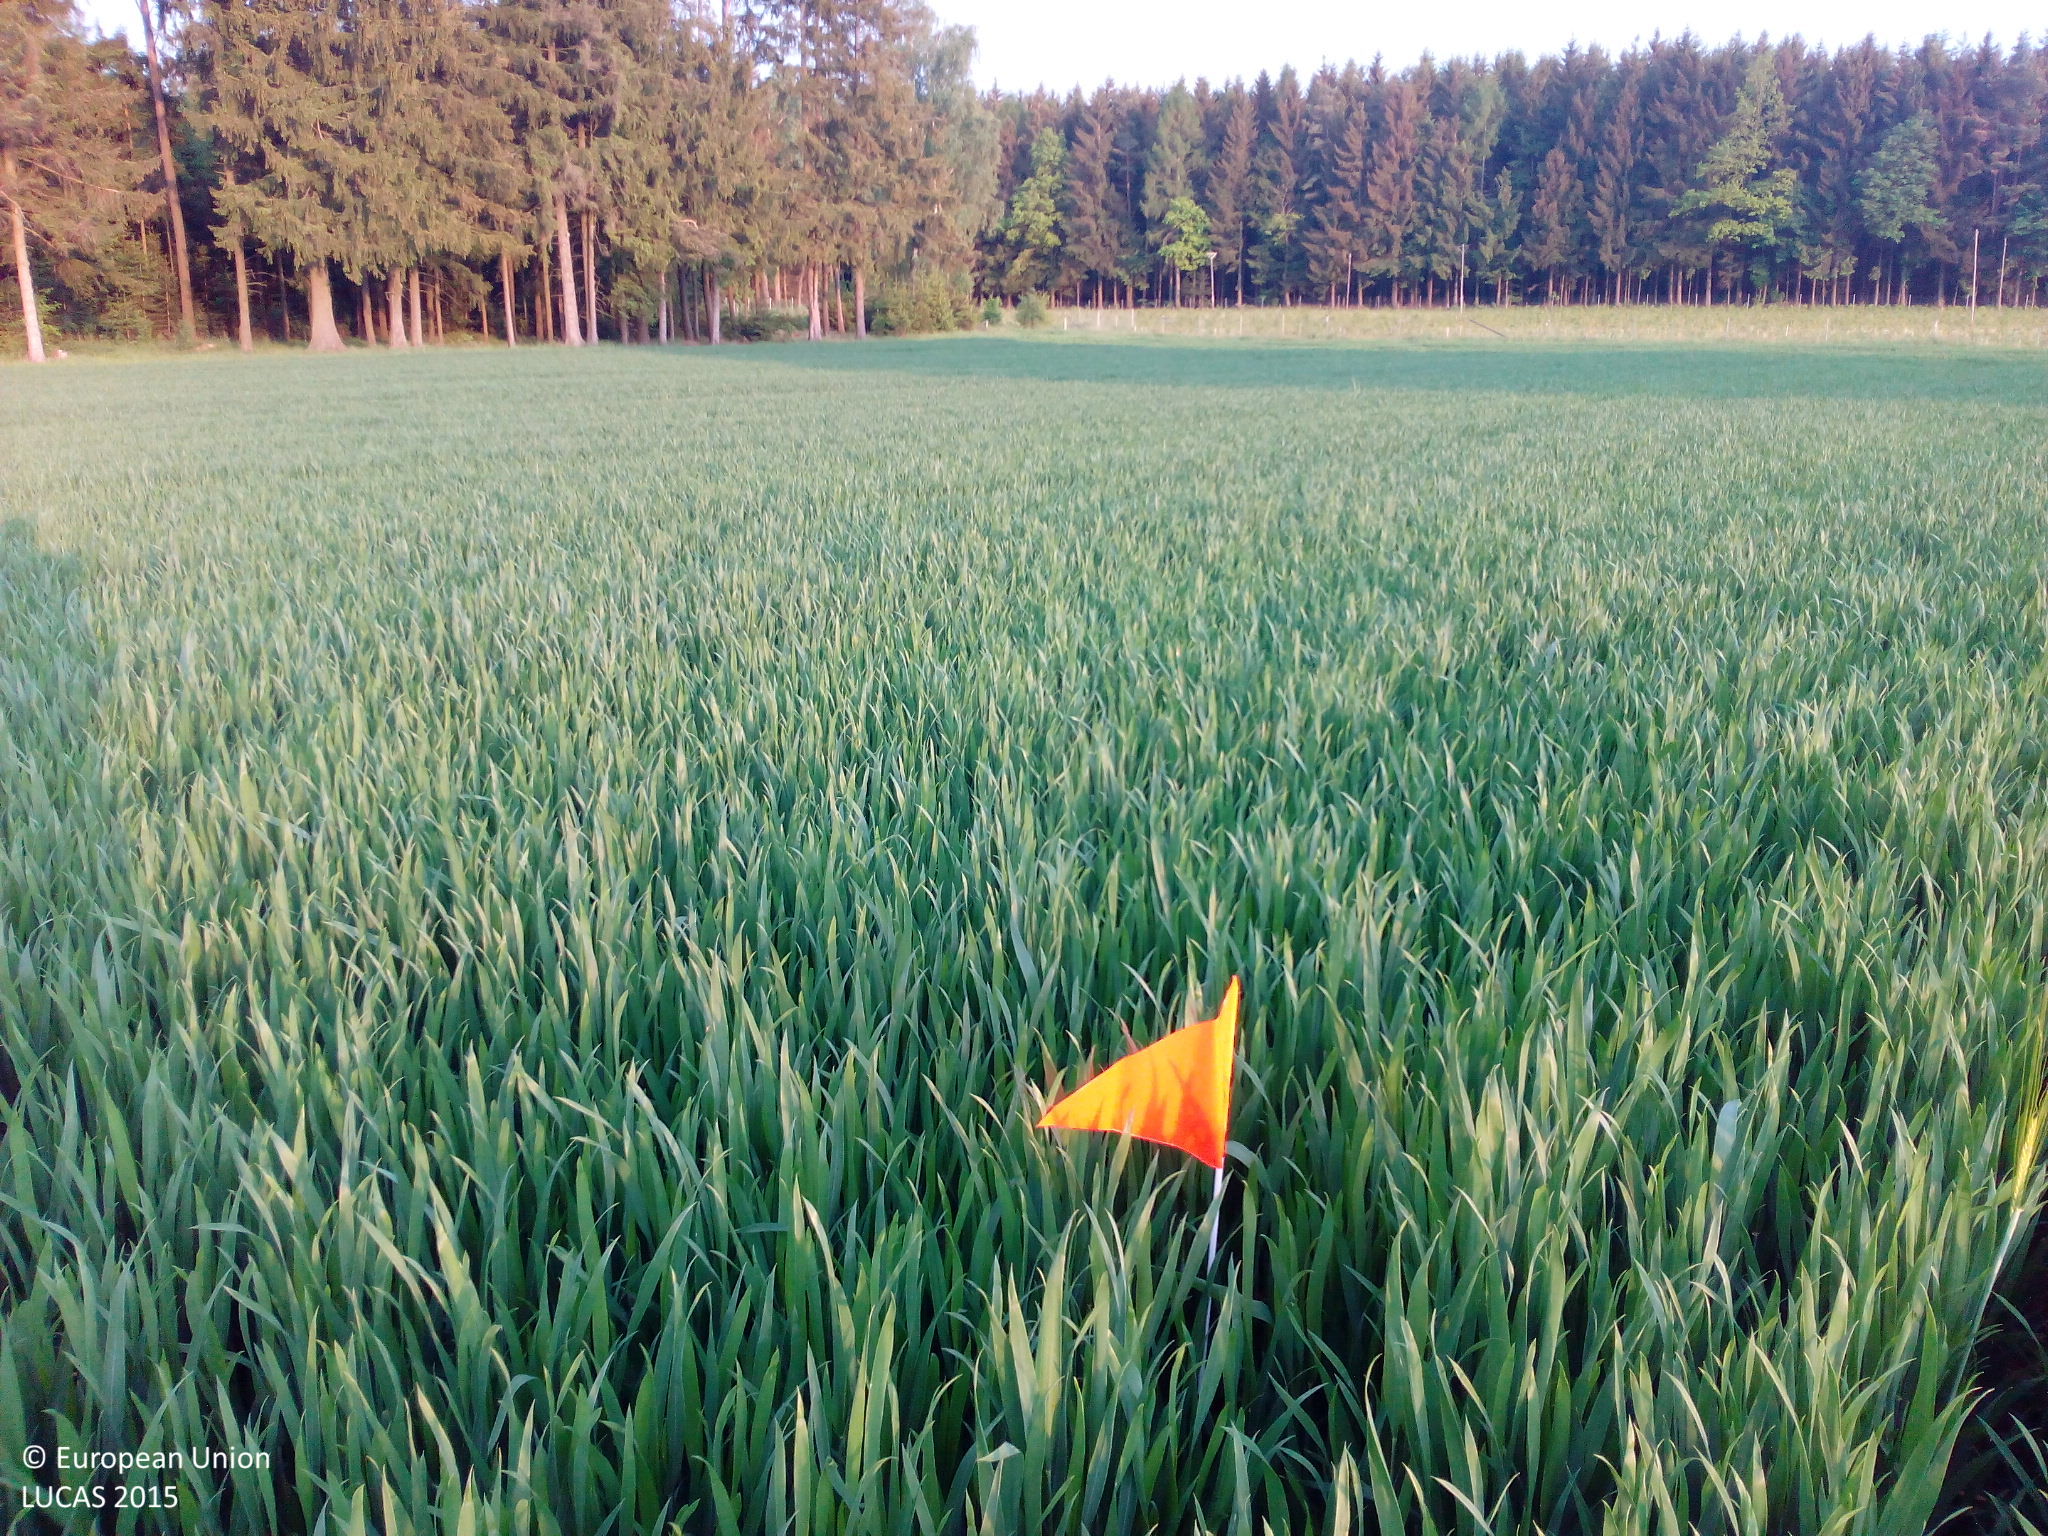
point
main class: Cropland
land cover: Common wheat
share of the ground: > 75 %
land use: Agriculture (excluding fallow land and kitchen gardens)
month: May
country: DE
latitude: 48.9693
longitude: 11.4884
